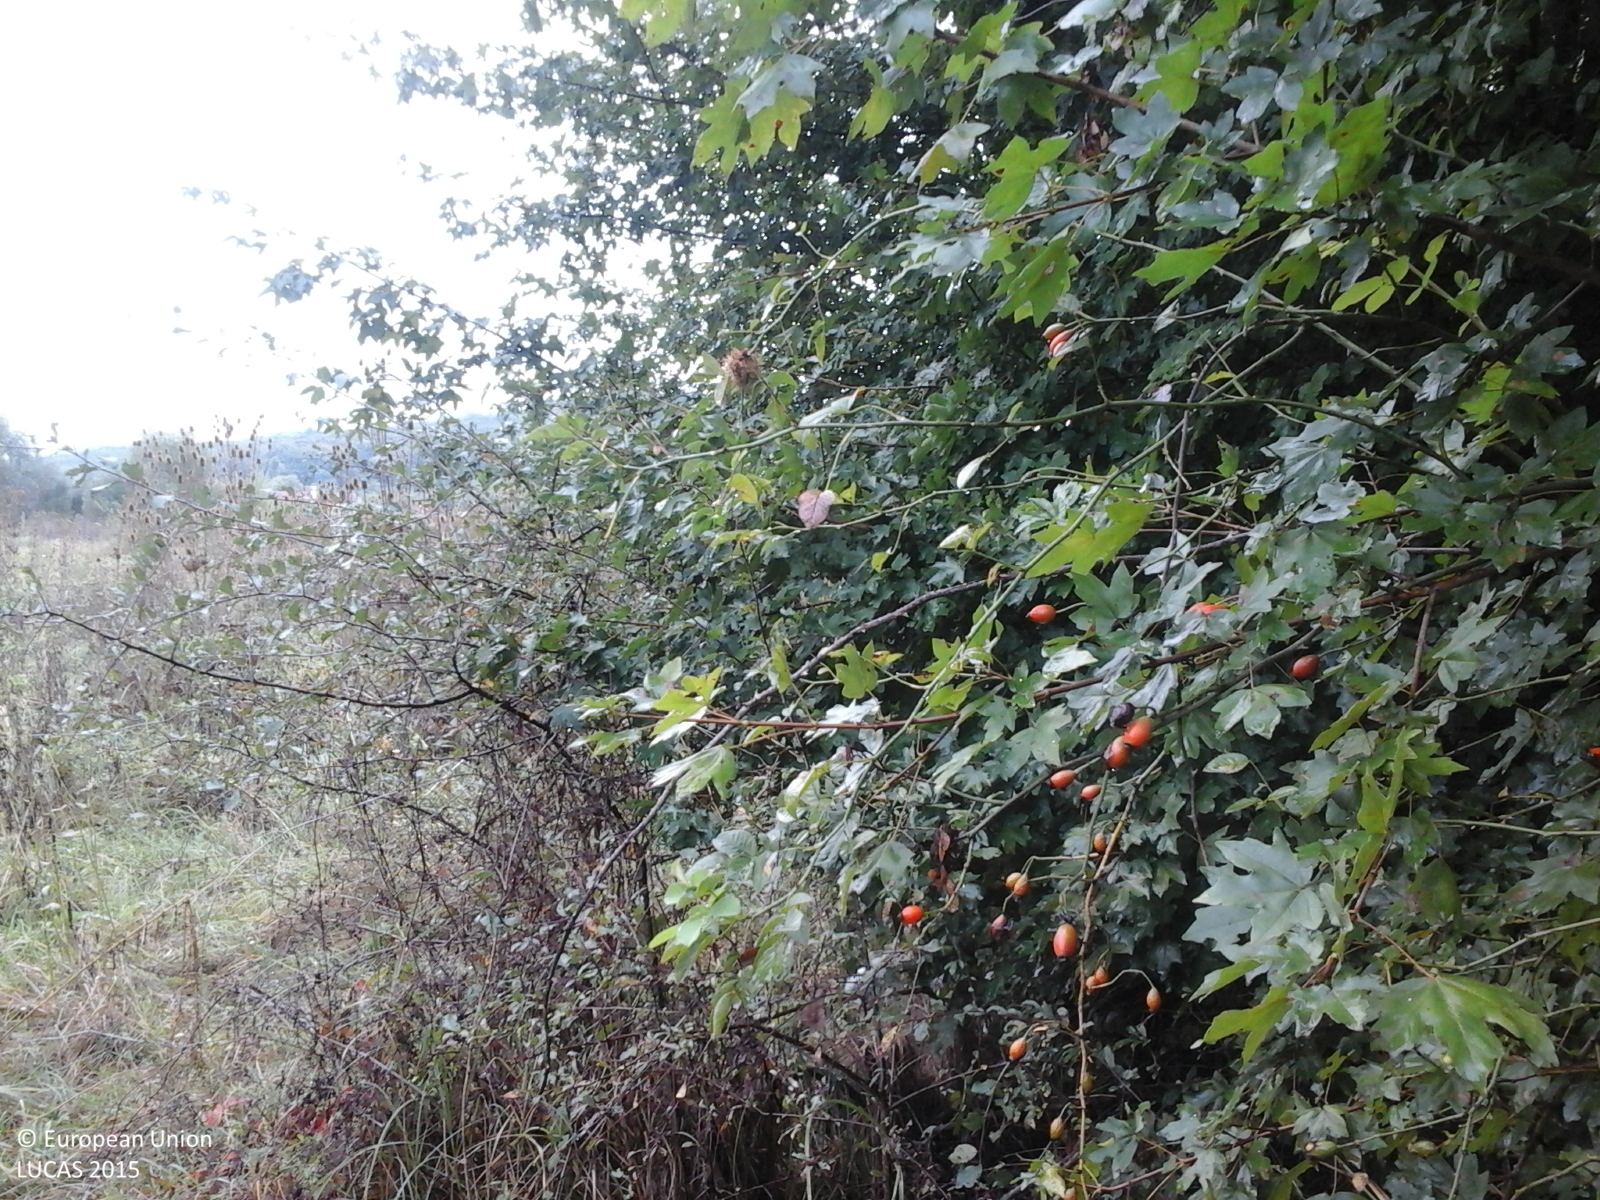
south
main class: Woodland
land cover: Broadleaved woodland
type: non-riverine alder, birch or aspen forest
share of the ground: > 75 %
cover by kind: broadleaved forest trees 100 %
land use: Forestry
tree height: > 5 m
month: September
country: RO
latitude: 46.9657
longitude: 21.9935
